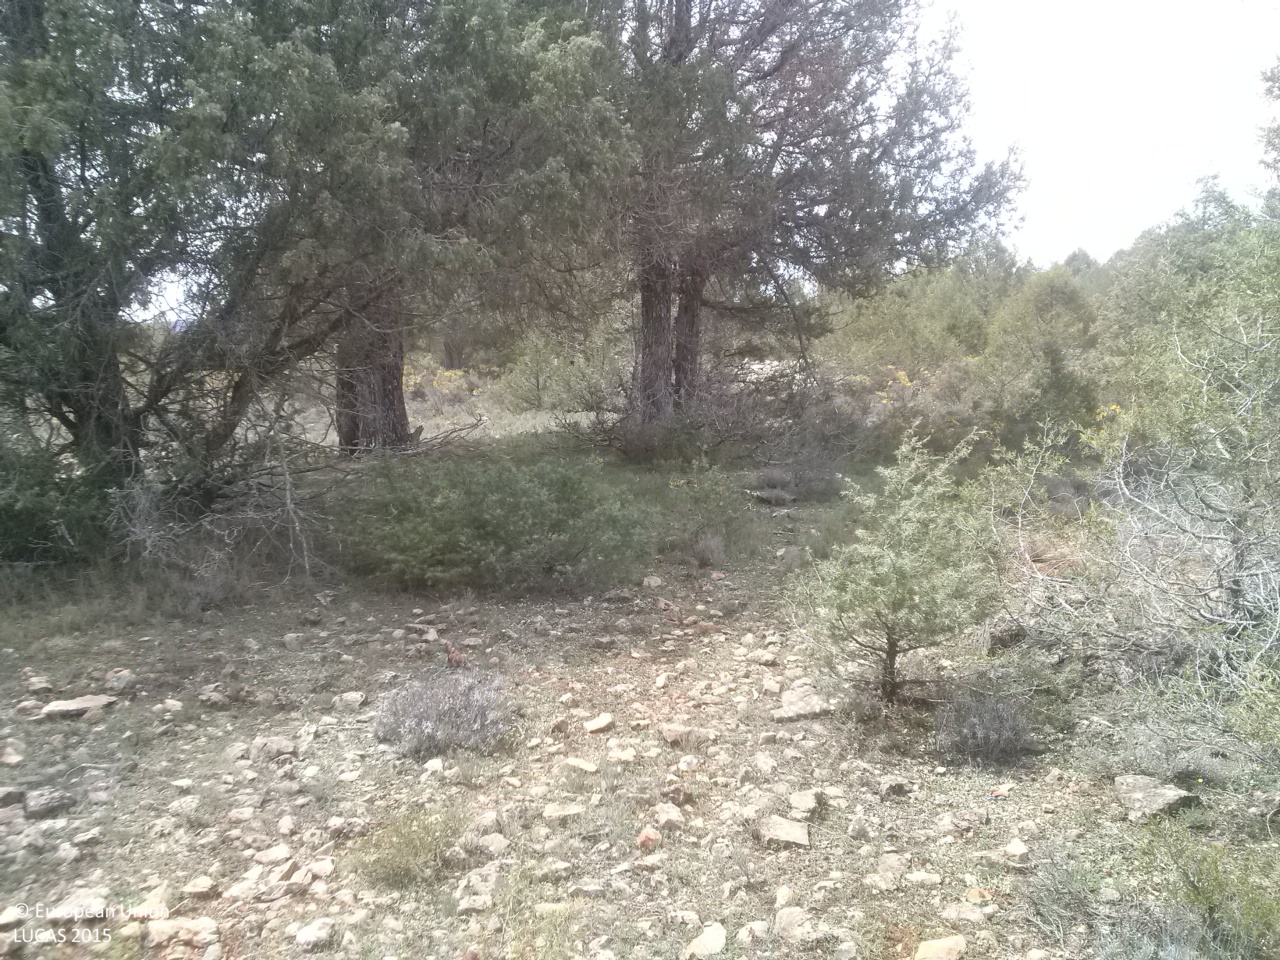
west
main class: Woodland
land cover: Other coniferous woodland
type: coniferous forest of the mediterranean region
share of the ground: 10 - 25 %
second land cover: Grassland without tree/shrub cover
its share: 50 - 75 %
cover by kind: herbaceous plants 60 %, coniferous forest trees 20 %, unconsolidated bare surface 15 %, shrubs 5 %
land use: Forestry
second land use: Agriculture (excluding fallow land and kitchen gardens)
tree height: > 5 m
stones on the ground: > 50 %
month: April
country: ES
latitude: 40.0410
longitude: -1.8386
